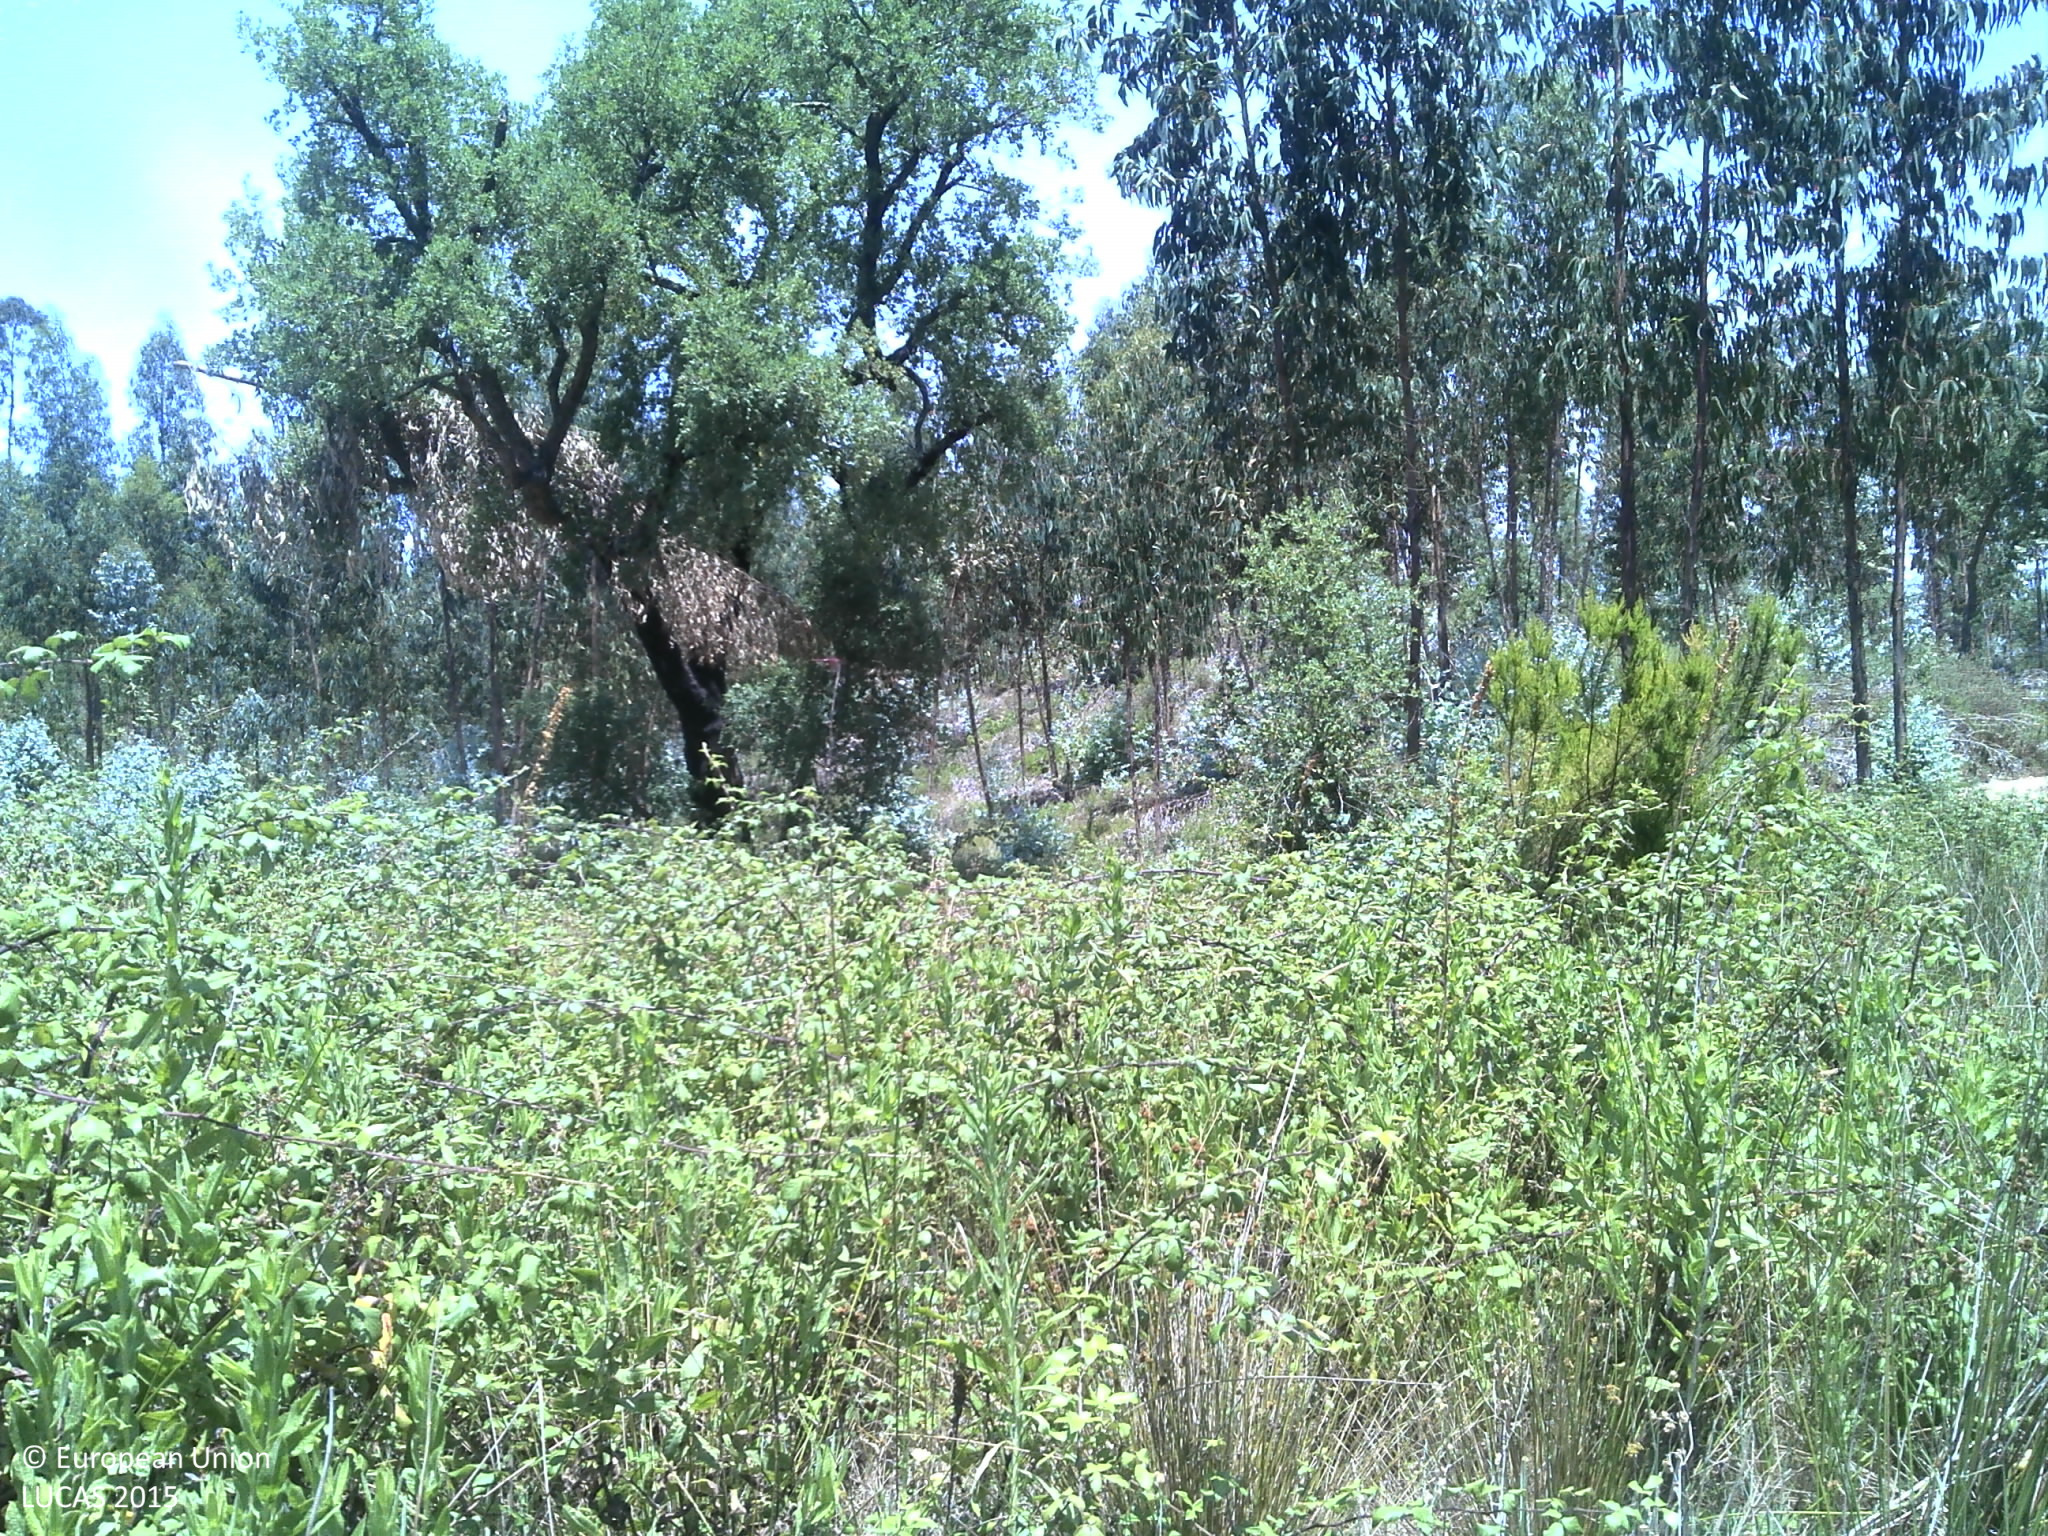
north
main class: Shrubland
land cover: Shrubland without tree cover
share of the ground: 25 - 50 %
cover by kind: unconsolidated bare surface 50 %, shrubs 40 %, herbaceous plants 10 %
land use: Semi-natural and natural areas not in use
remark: Temporary dry
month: July
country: PT
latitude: 39.2527
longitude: -8.2901
